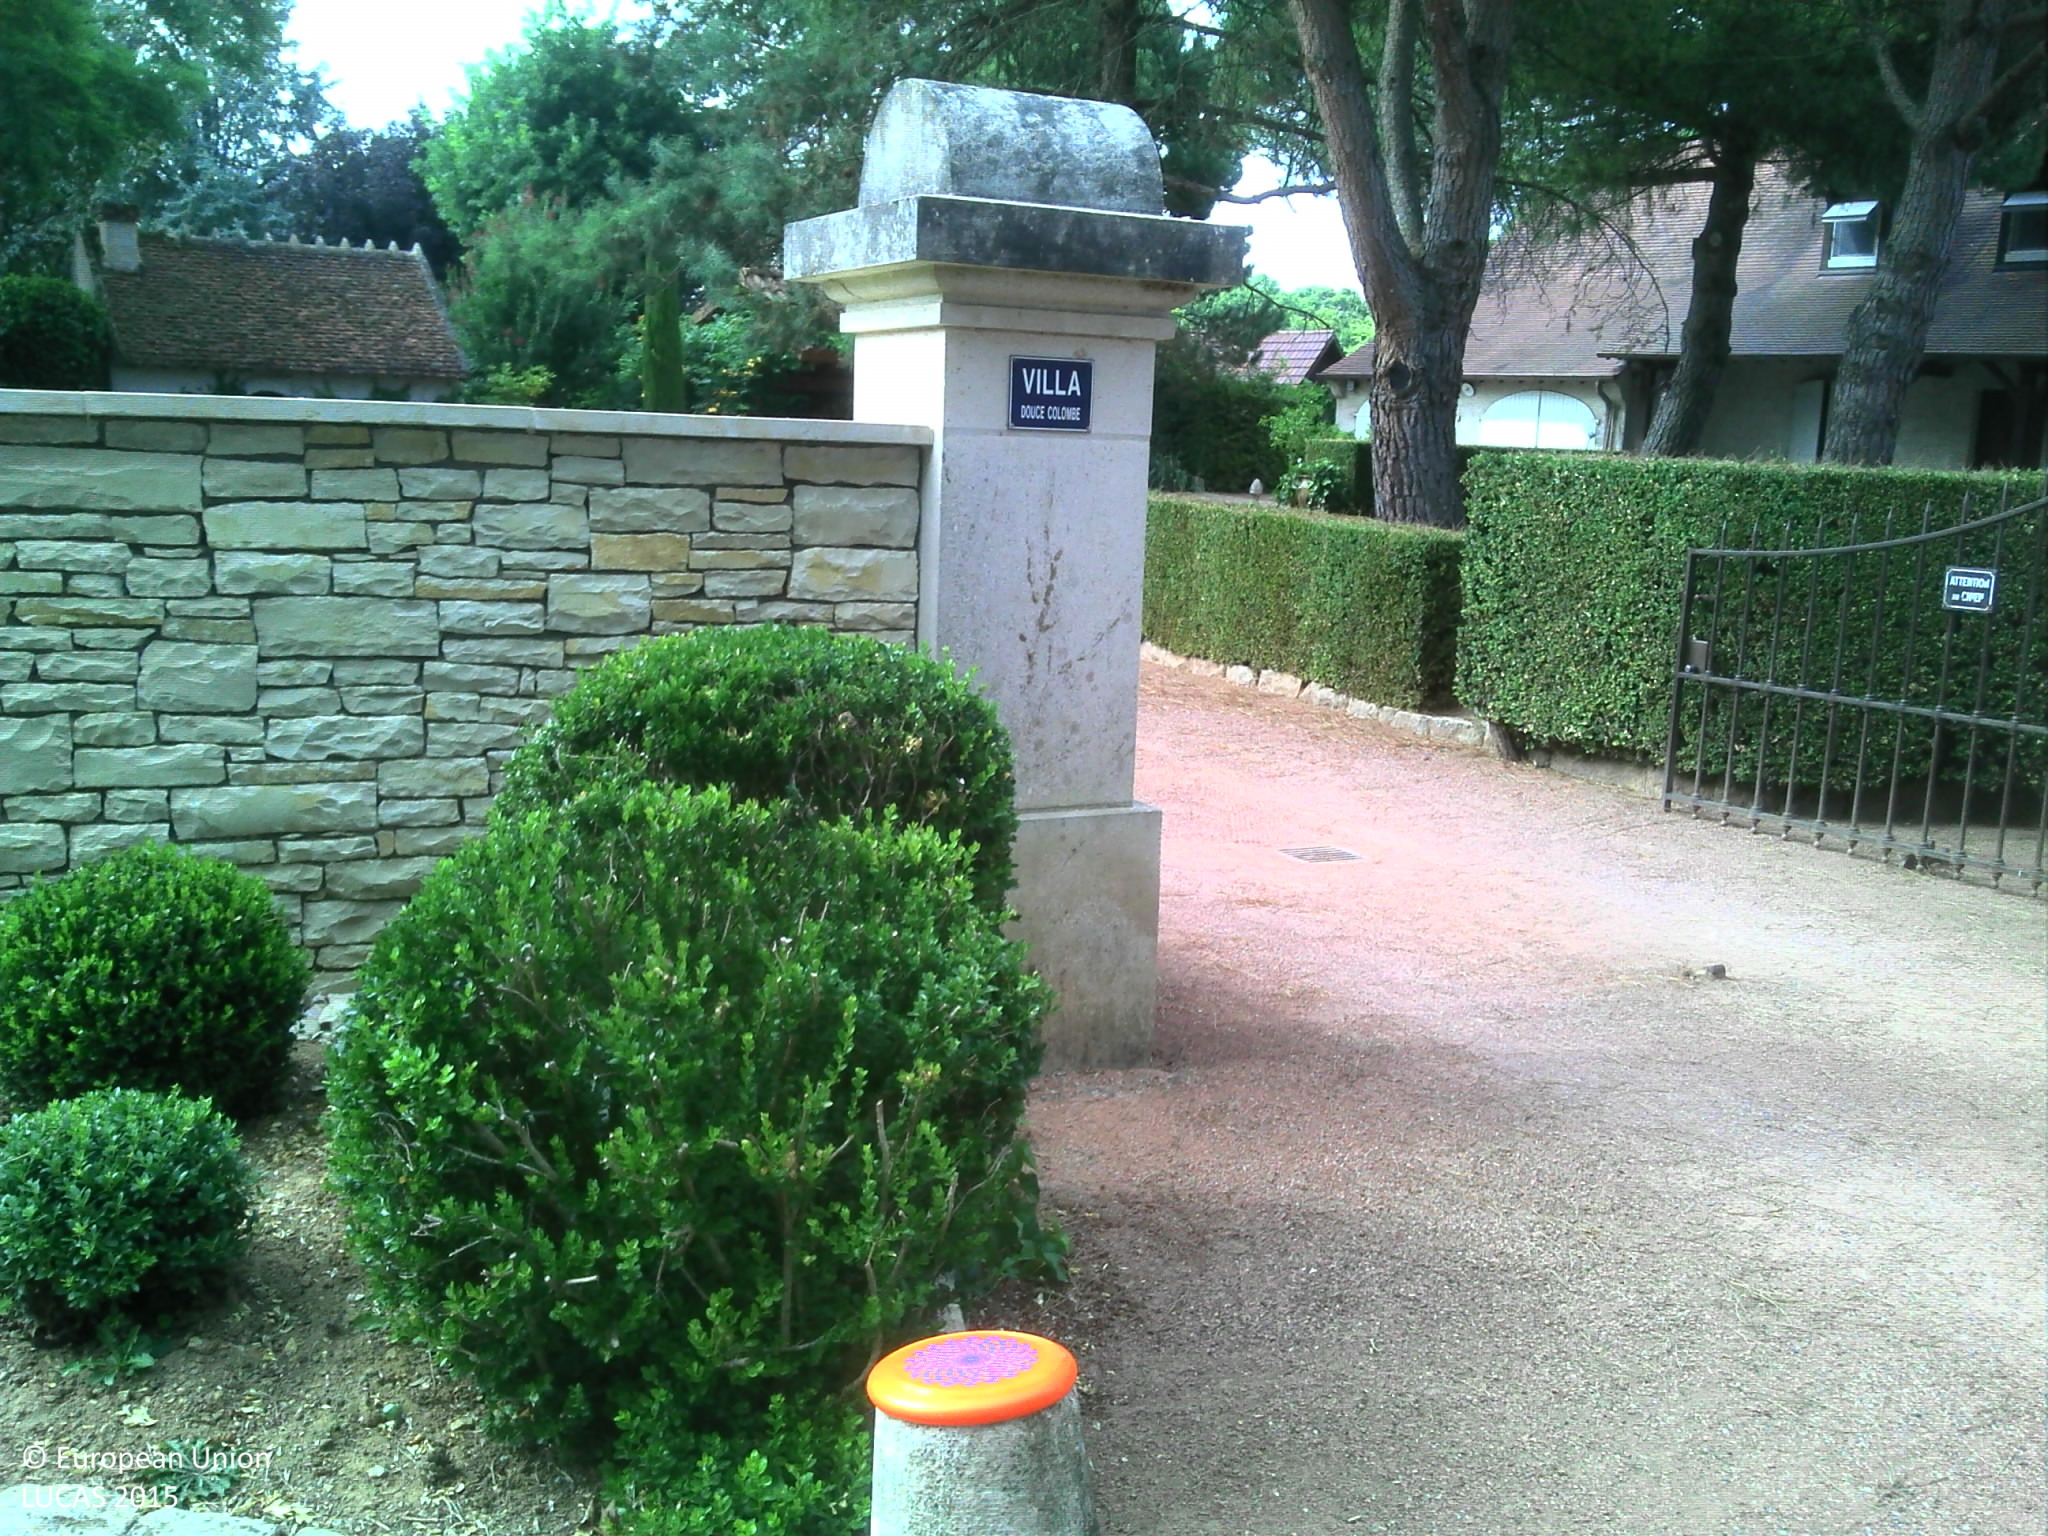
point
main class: Woodland
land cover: Broadleaved woodland
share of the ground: > 75 %
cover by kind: broadleaved forest trees 65 %, herbaceous plants 35 %
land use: Residential
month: July
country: FR
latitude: 46.8009
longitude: 4.7732
